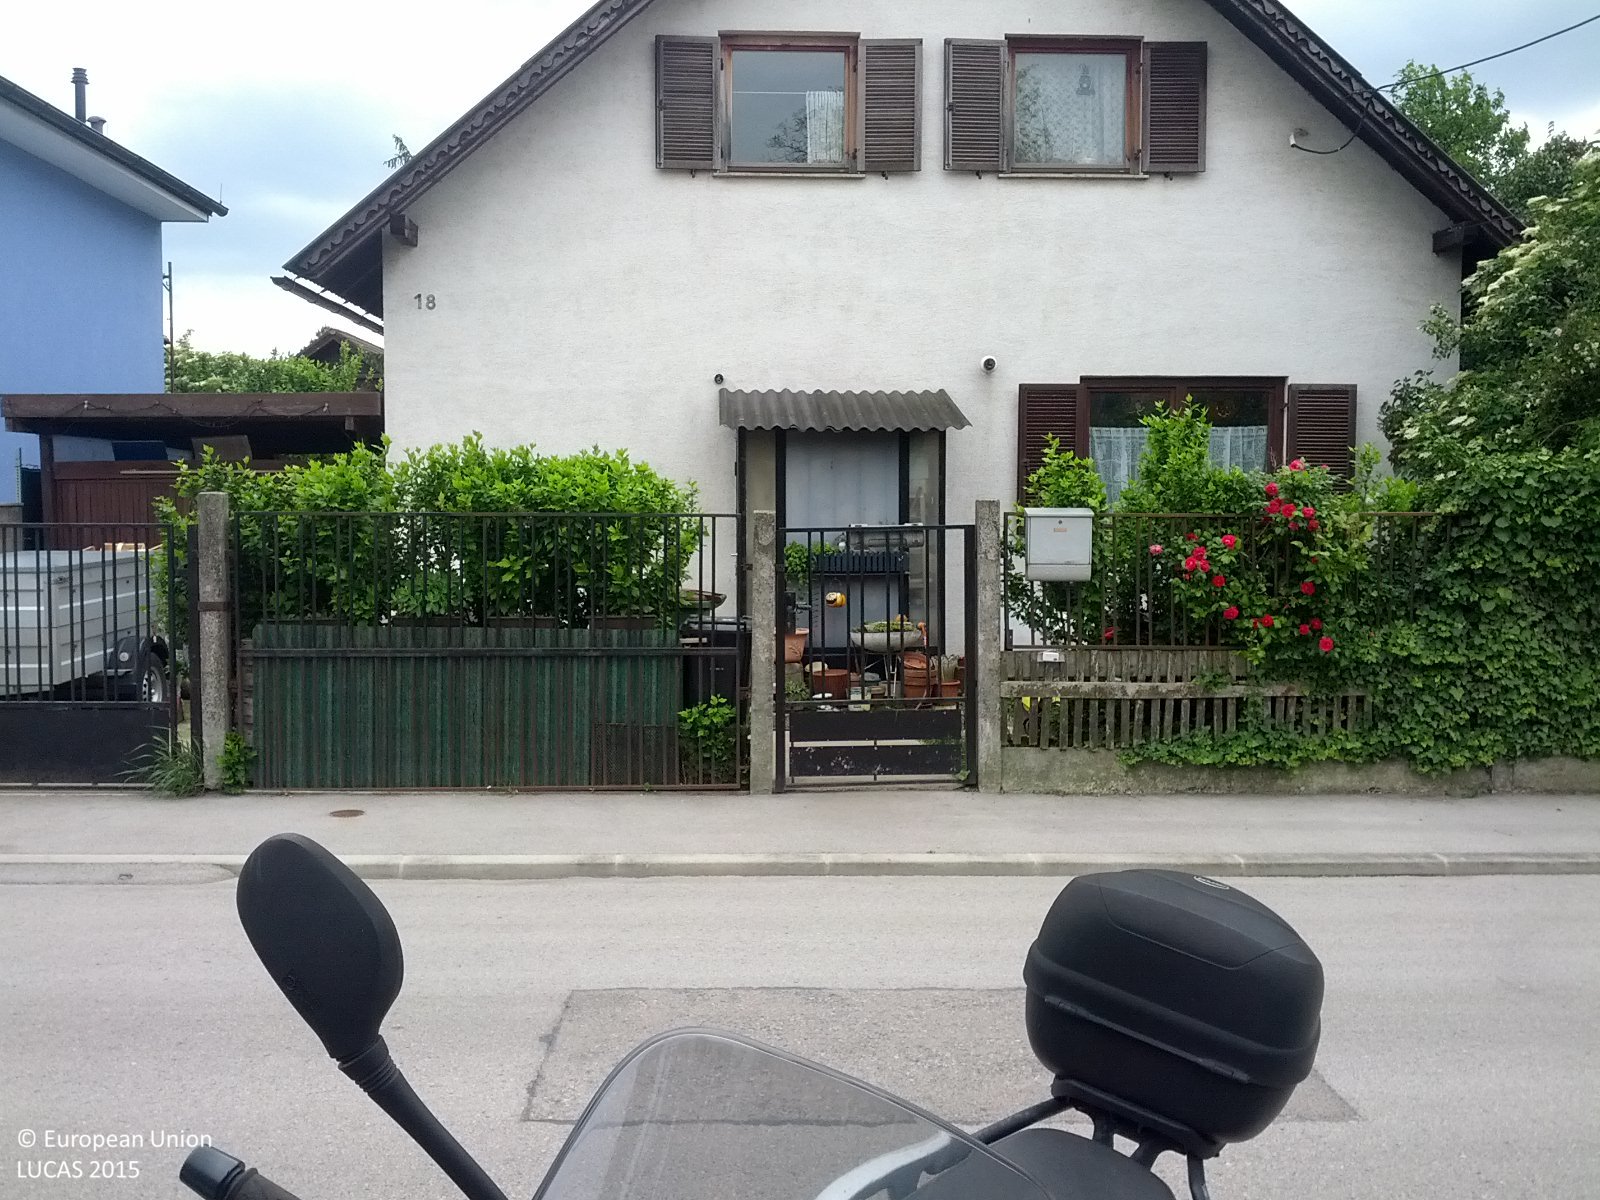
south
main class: Cropland
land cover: Nuts trees
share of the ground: 25 - 50 %
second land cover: Grassland without tree/shrub cover
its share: 50 - 75 %
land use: Kitchen garden
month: May
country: AT
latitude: 48.2282
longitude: 16.5347
